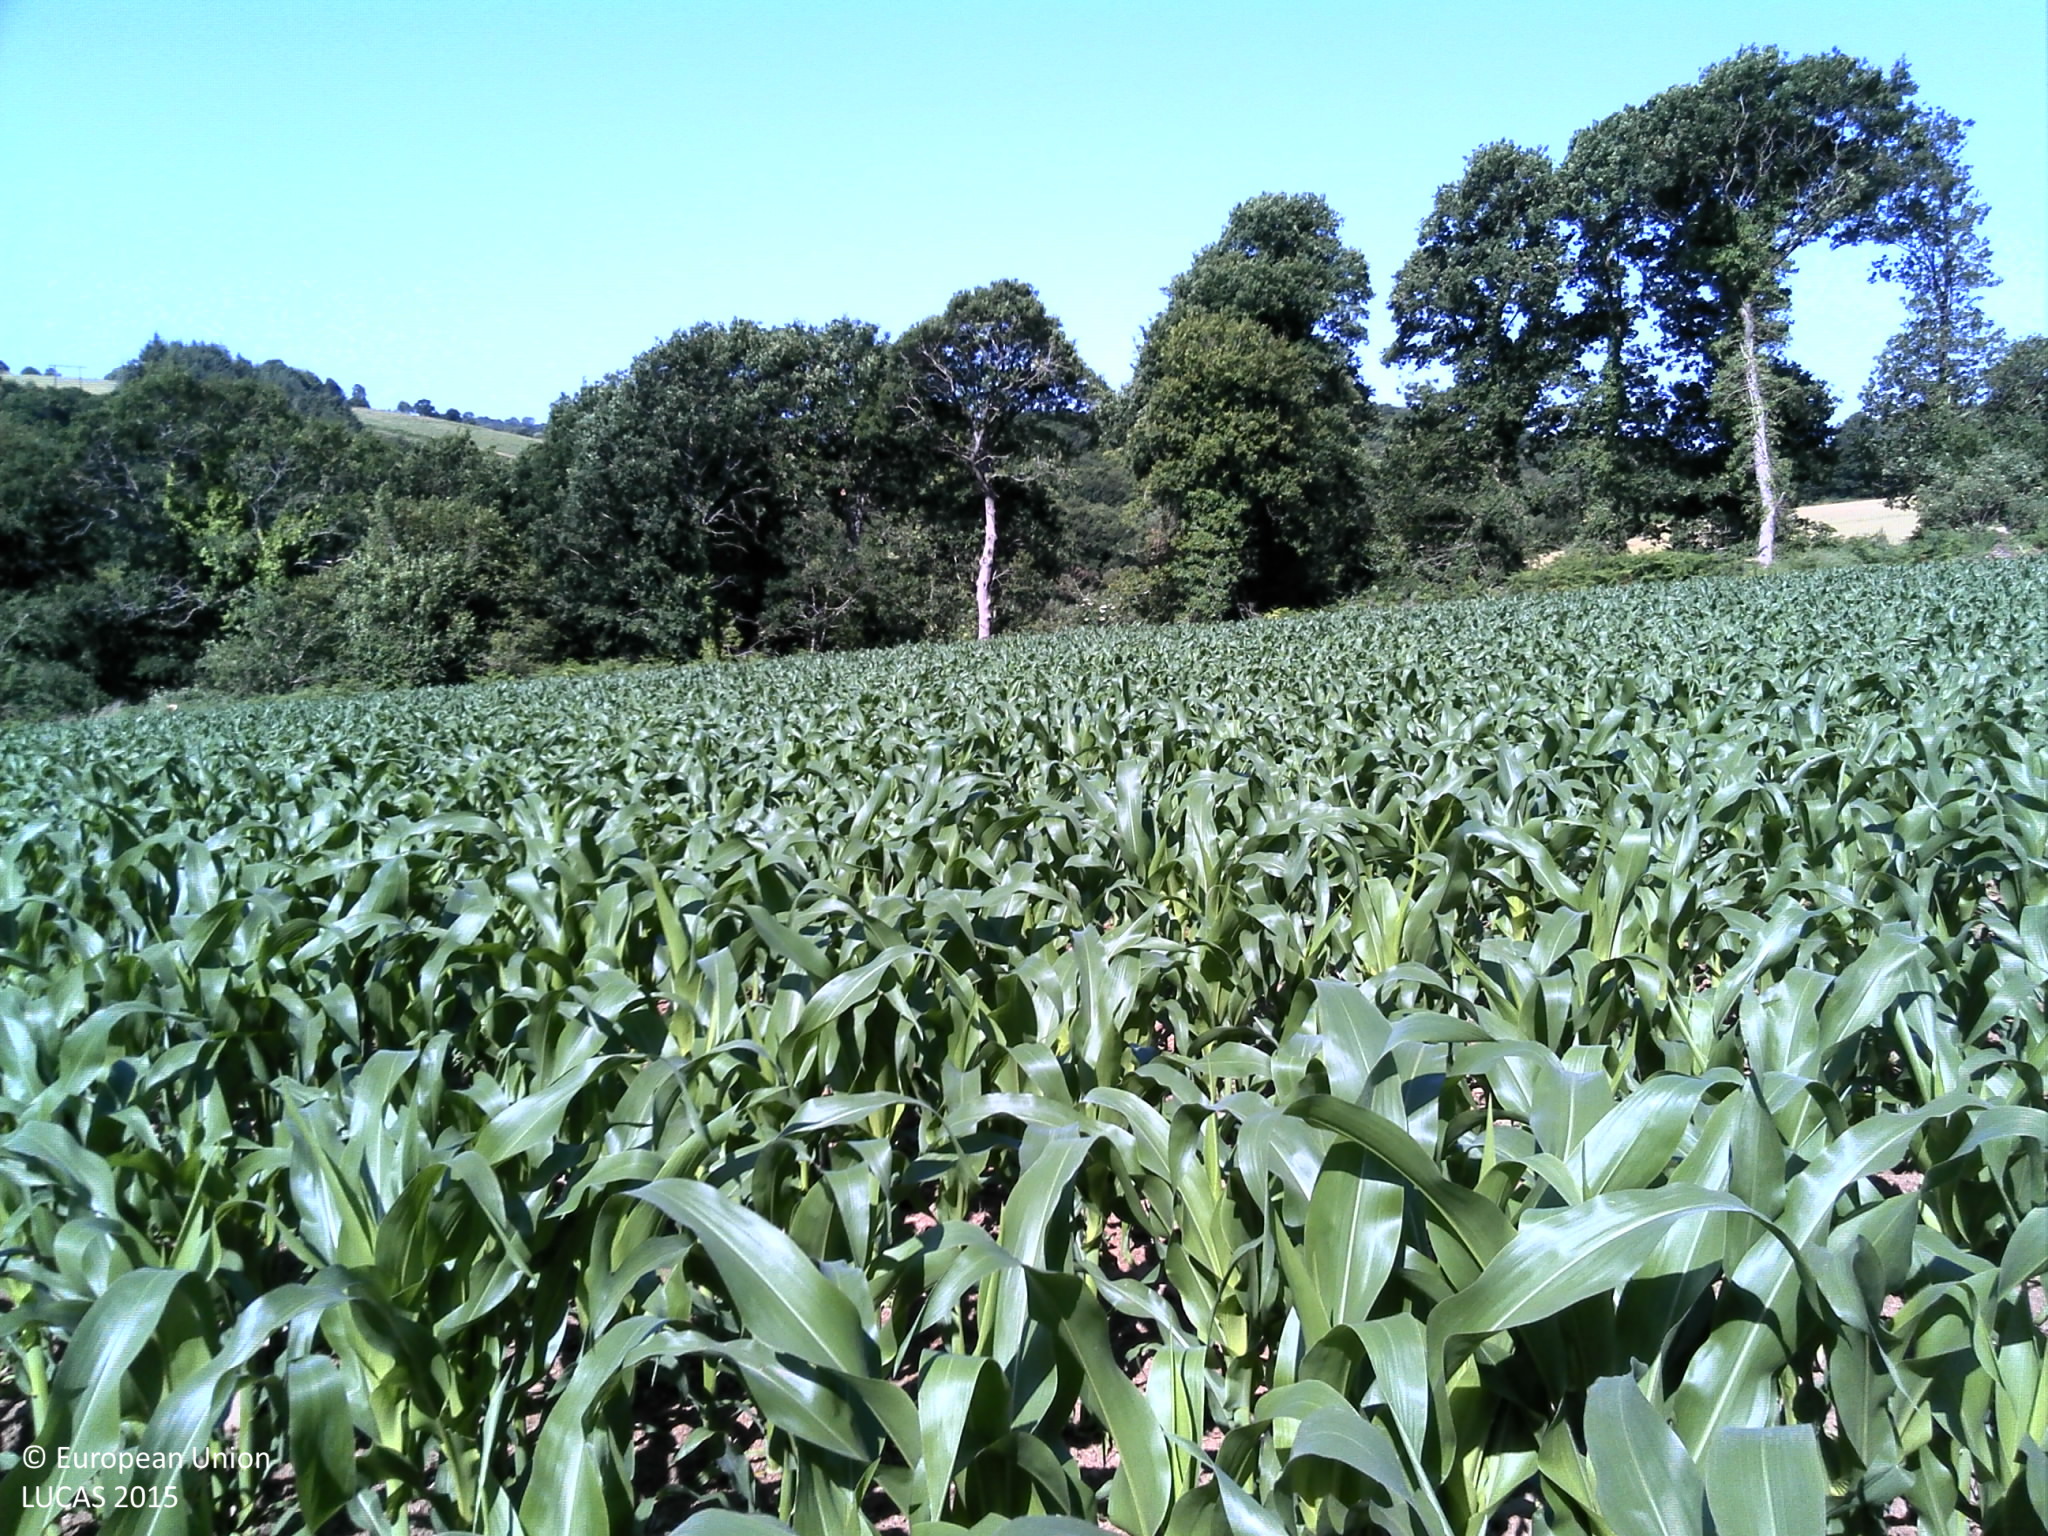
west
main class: Cropland
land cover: Maize
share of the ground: > 75 %
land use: Agriculture (excluding fallow land and kitchen gardens)
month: June
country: FR
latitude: 48.2178
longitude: -3.5788
